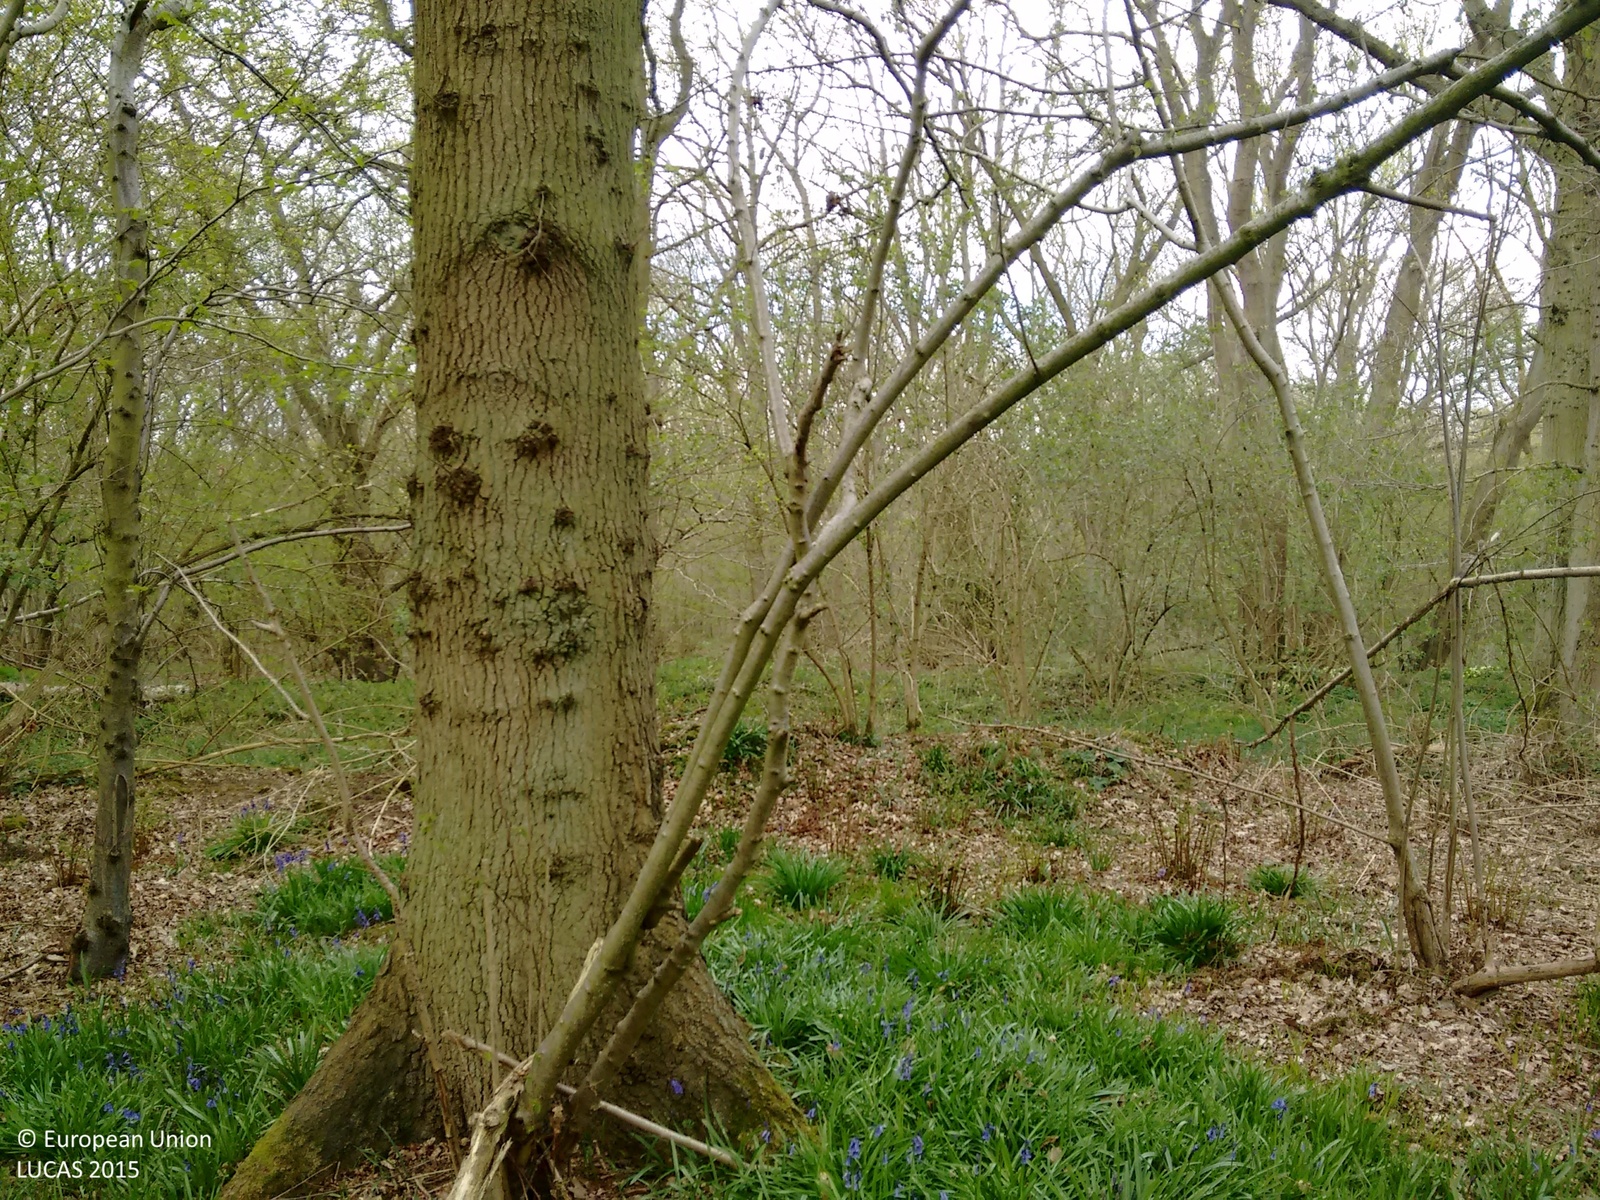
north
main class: Woodland
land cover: Broadleaved woodland
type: mesophytic deciduous forest
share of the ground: > 75 %
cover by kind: broadleaved forest trees 100 %
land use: Forestry
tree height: > 5 m
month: April
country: GB
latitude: 53.2408
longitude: -0.6329
